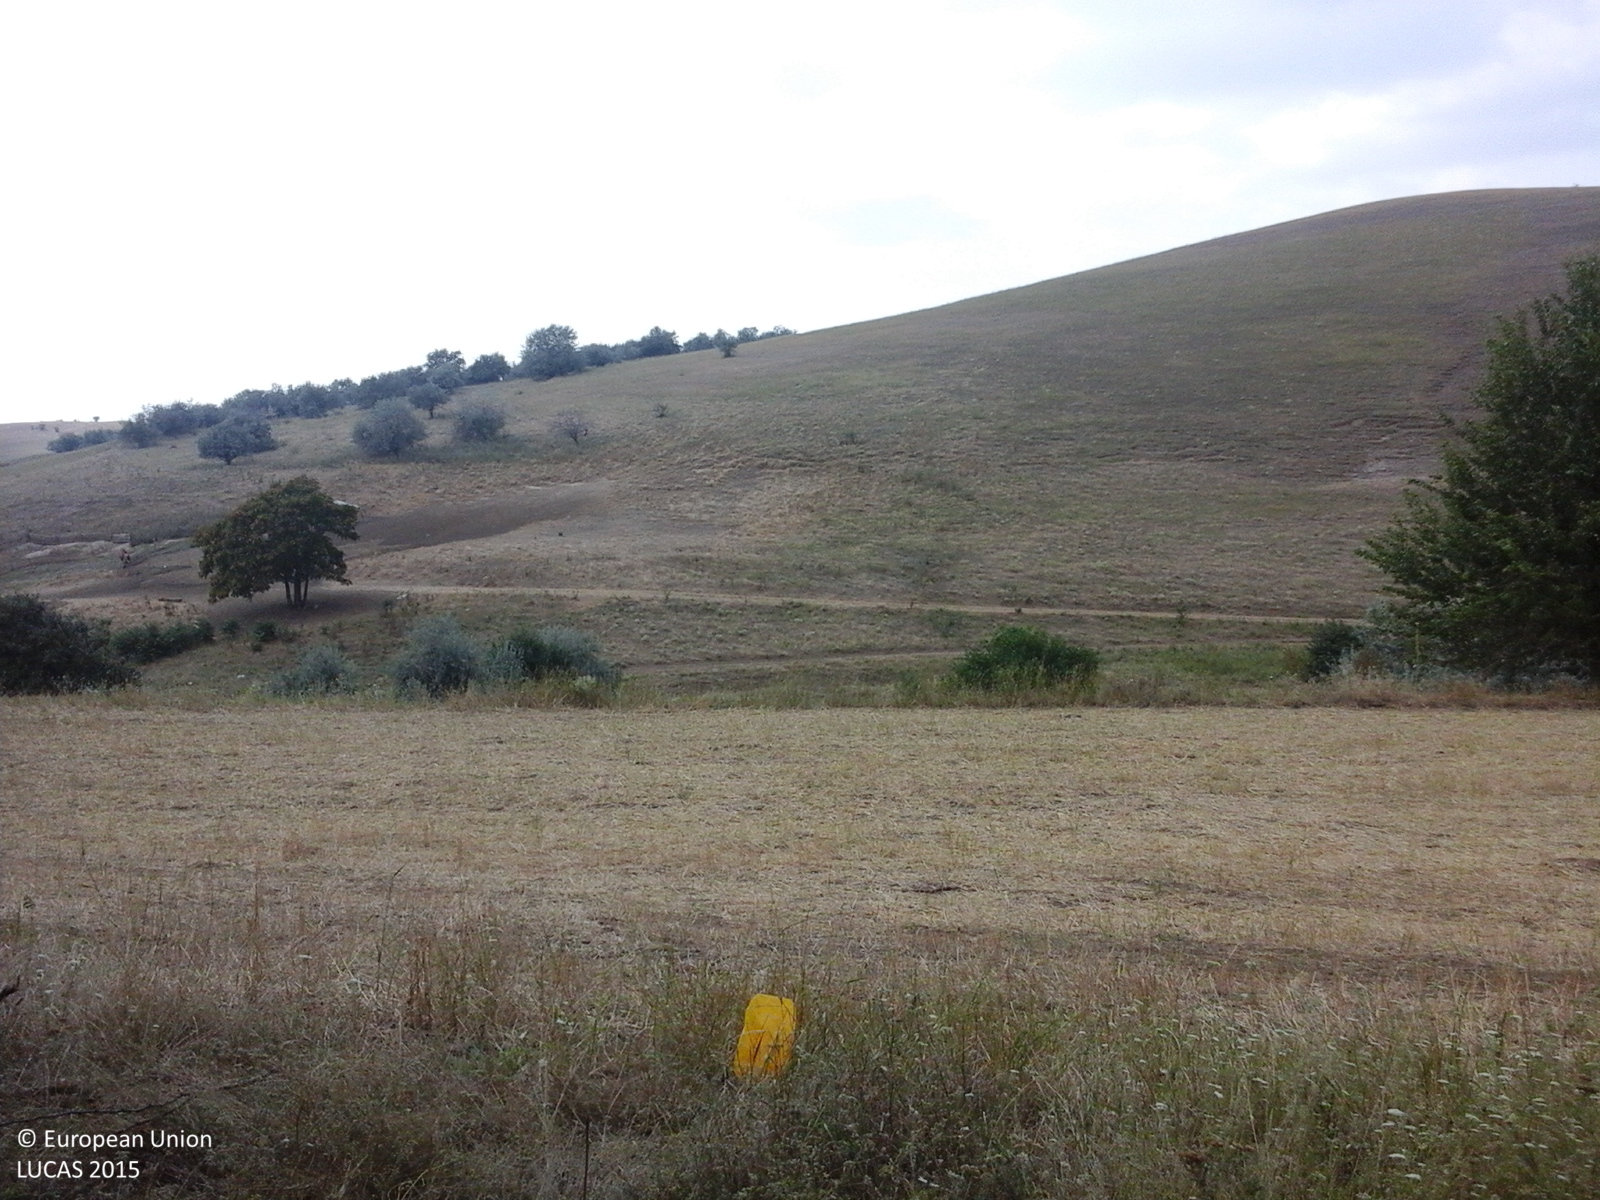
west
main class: Woodland
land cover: Broadleaved woodland
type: mesophytic deciduous forest
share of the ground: > 75 %
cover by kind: broadleaved forest trees 85 %, herbaceous plants 15 %
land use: Forestry
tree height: > 5 m
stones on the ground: 10 - 25 %
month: July
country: RO
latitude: 44.9816
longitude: 28.3737
